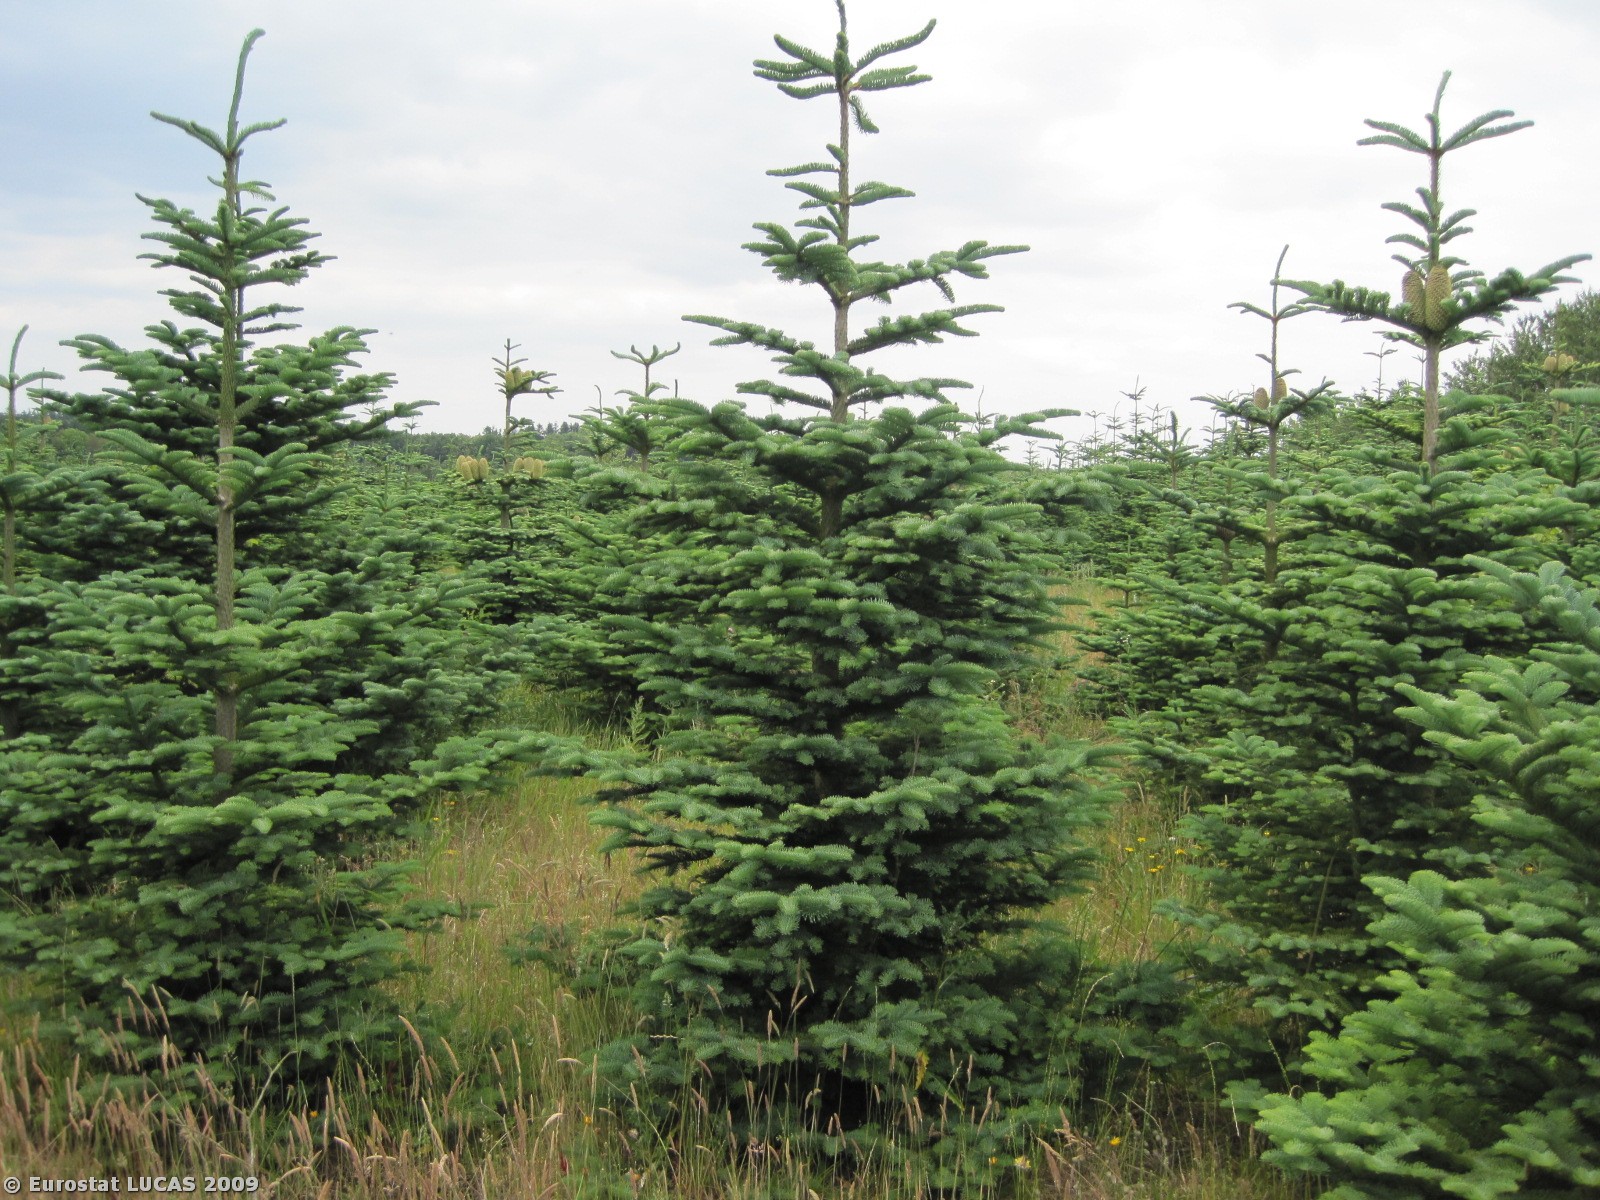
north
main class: Woodland
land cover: Coniferous woodland
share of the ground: 50 - 75 %
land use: Forestry
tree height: > 5 m
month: June
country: DK
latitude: 56.3216
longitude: 8.4011
